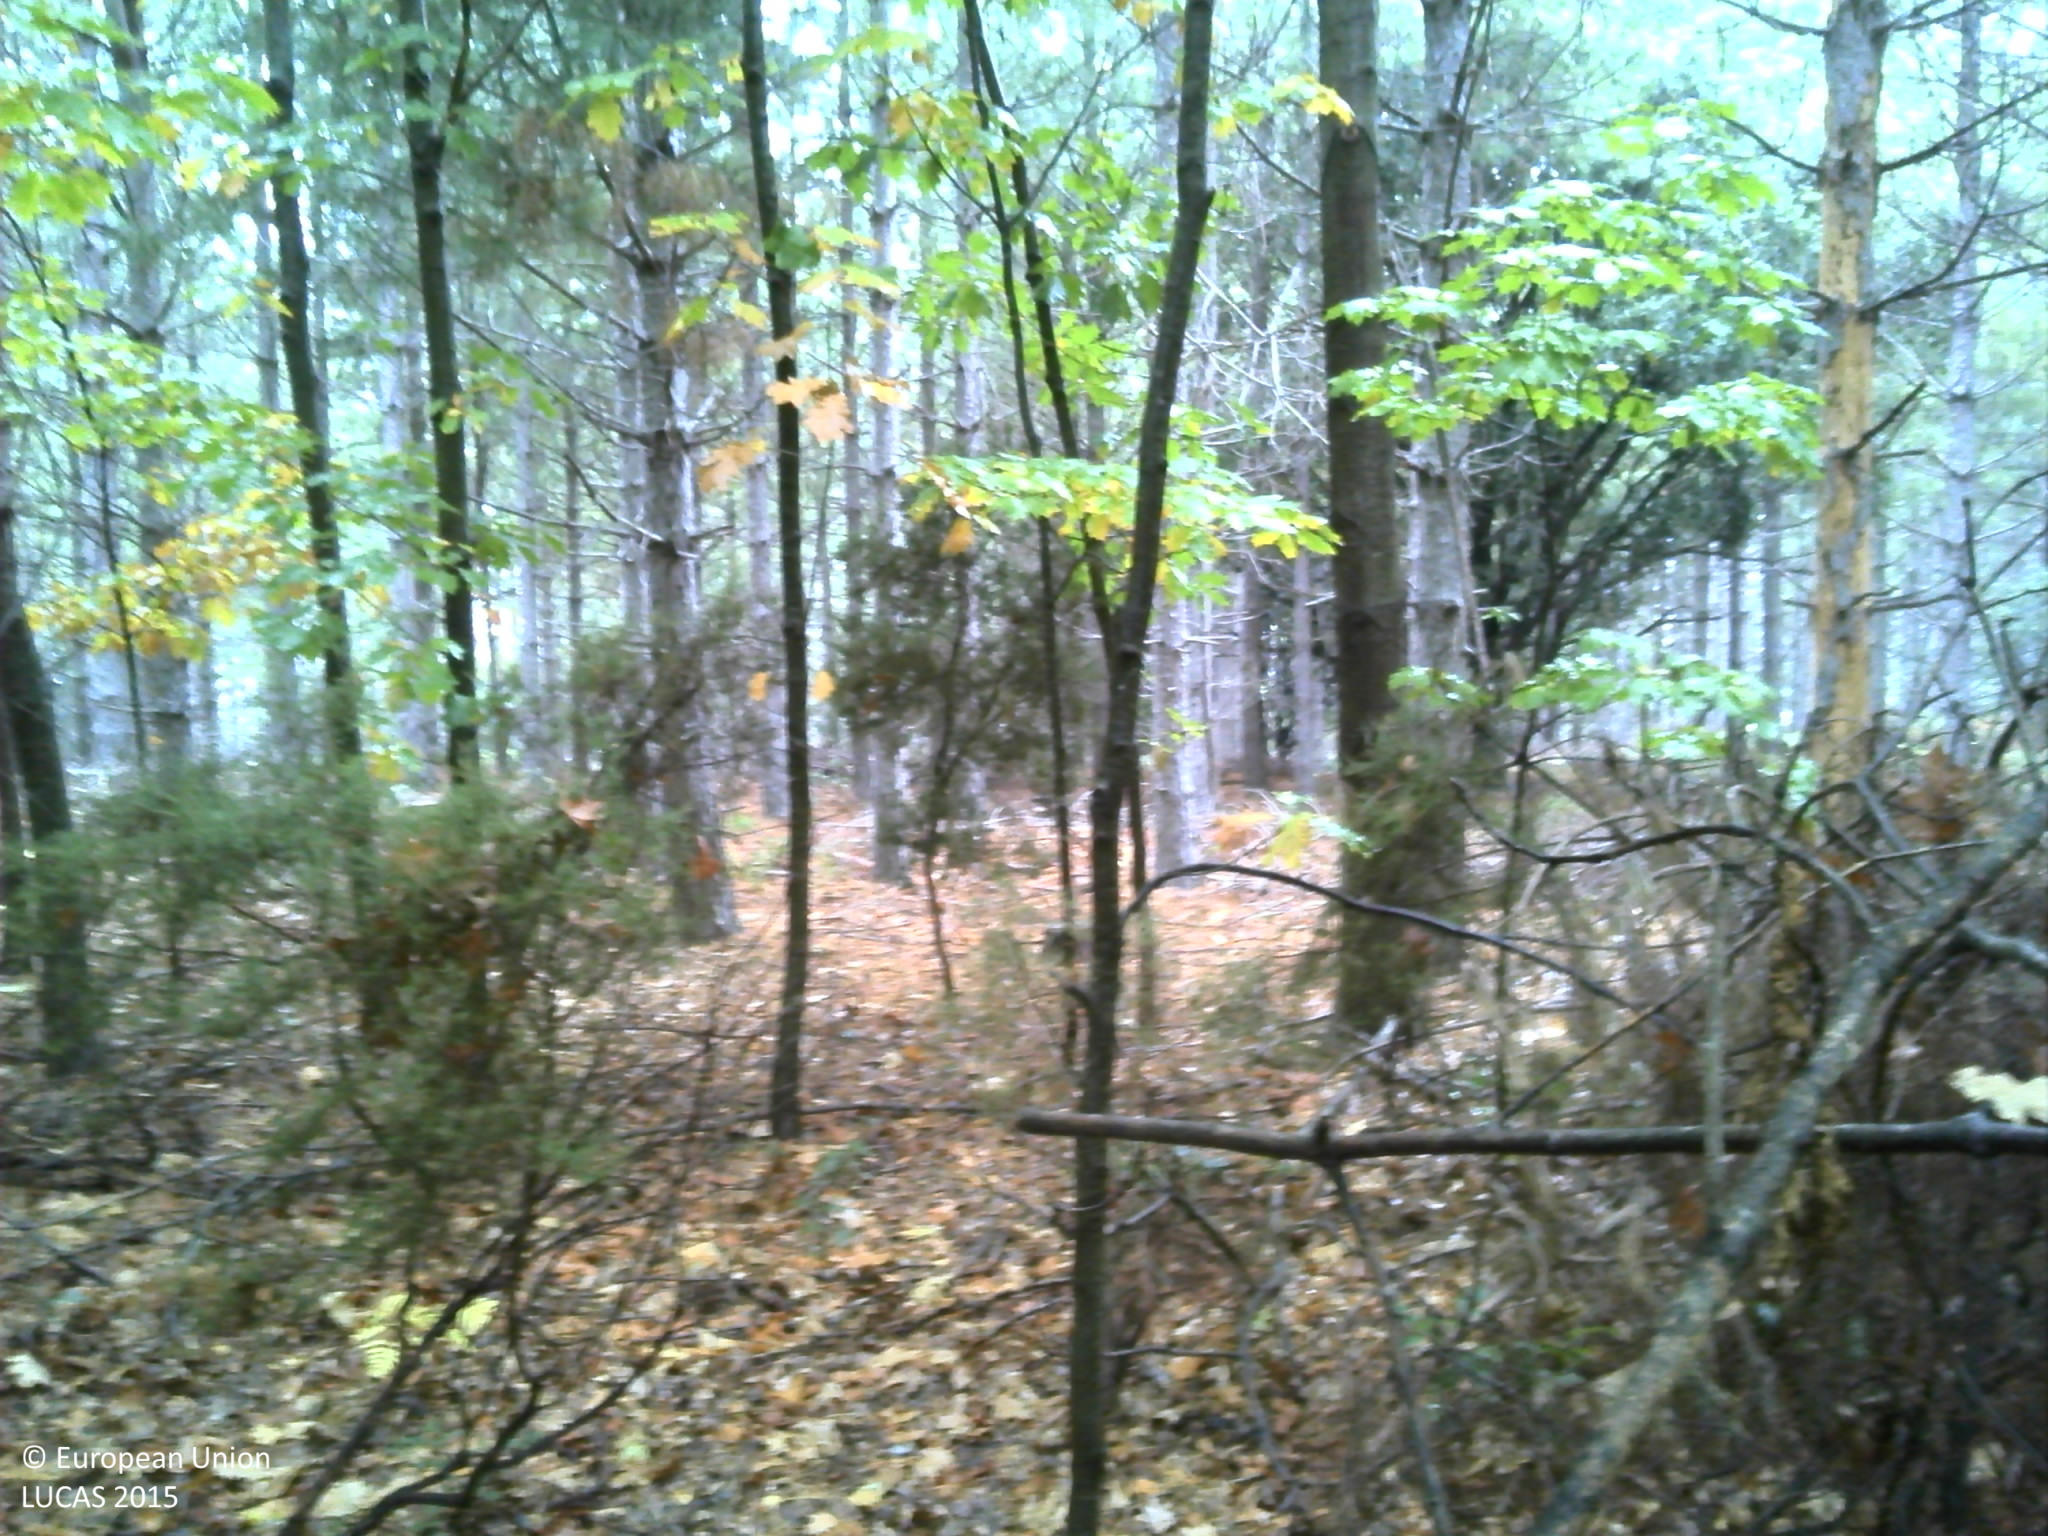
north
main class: Woodland
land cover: Pine dominated mixed woodland
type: mesophytic deciduous forest
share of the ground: > 75 %
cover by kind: coniferous forest trees 50 %, broadleaved forest trees 30 %, unconsolidated bare surface 20 %
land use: Forestry
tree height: > 5 m
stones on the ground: < 10 %
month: October
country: FR
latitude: 43.6110
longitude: 3.0570
